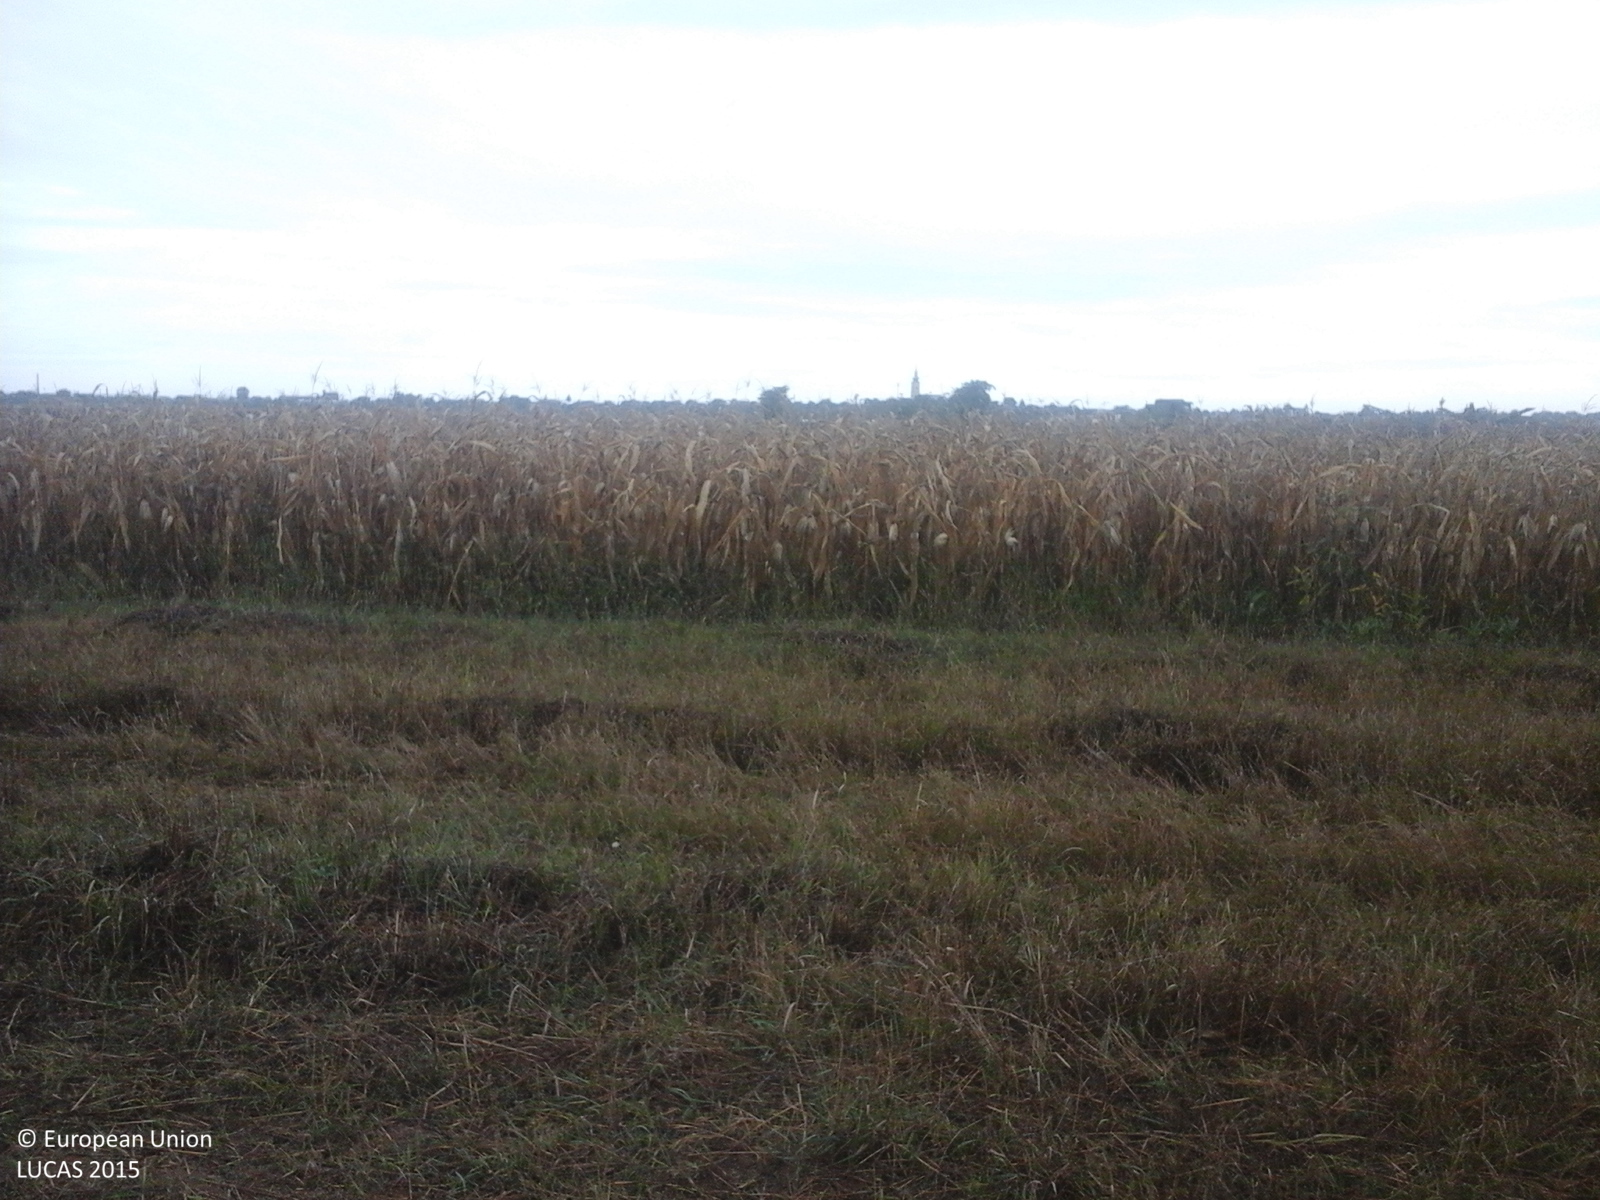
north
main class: Cropland
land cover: Common wheat
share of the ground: 10 - 25 %
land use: Agriculture (excluding fallow land and kitchen gardens)
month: September
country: RO
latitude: 47.2433
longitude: 21.9508
